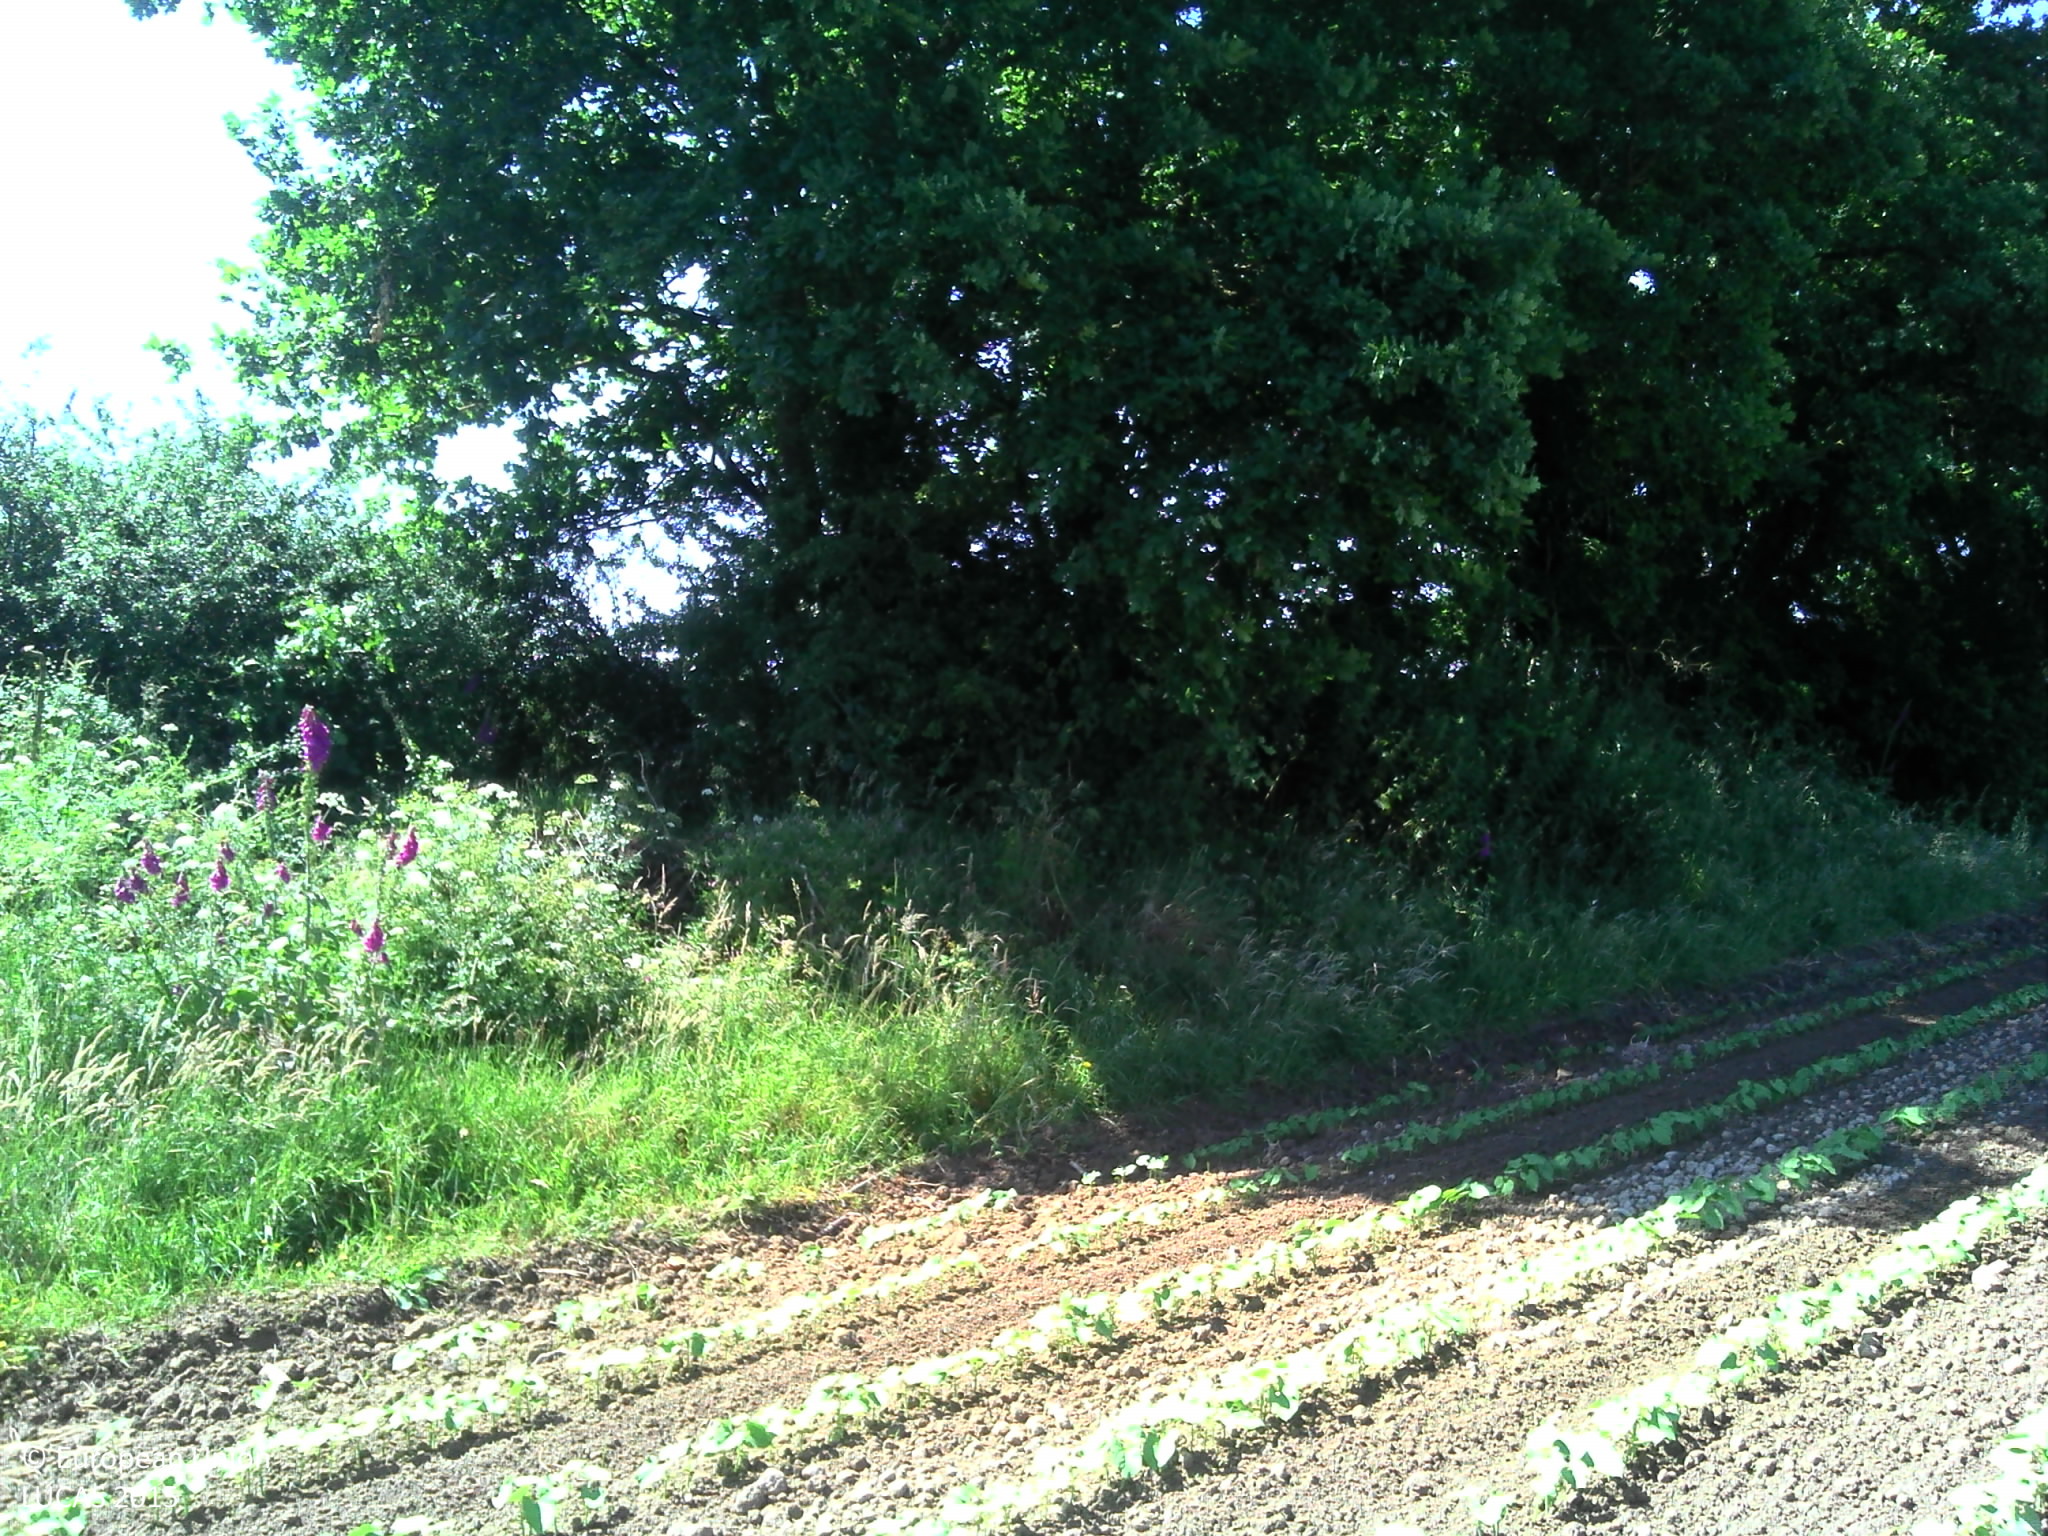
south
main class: Cropland
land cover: Dry pulses
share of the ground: 10 - 25 %
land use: Agriculture (excluding fallow land and kitchen gardens)
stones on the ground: < 10 %
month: June
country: FR
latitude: 46.7916
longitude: -1.4226
